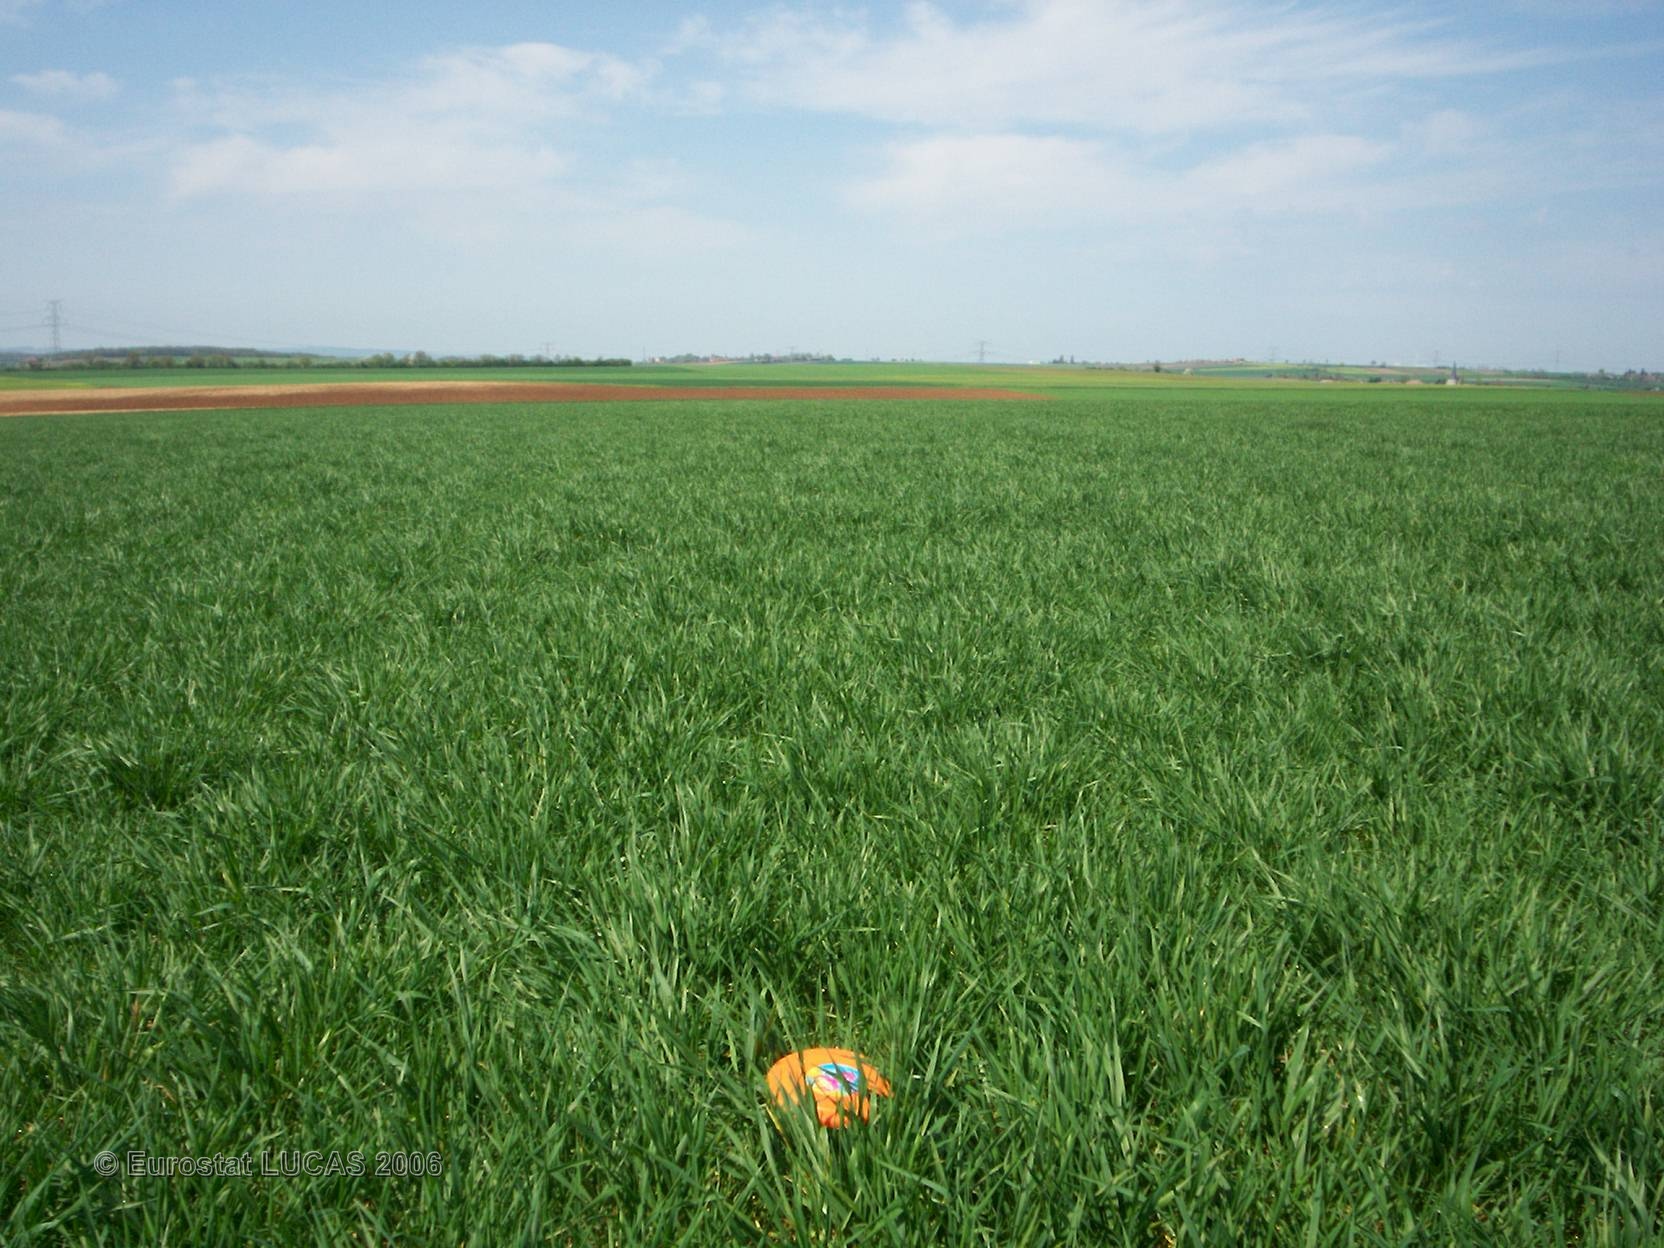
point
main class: Cropland
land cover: Common wheat
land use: Agriculture (excluding fallow land and kitchen gardens)
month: April
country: FR
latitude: 47.3697
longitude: 3.0158
